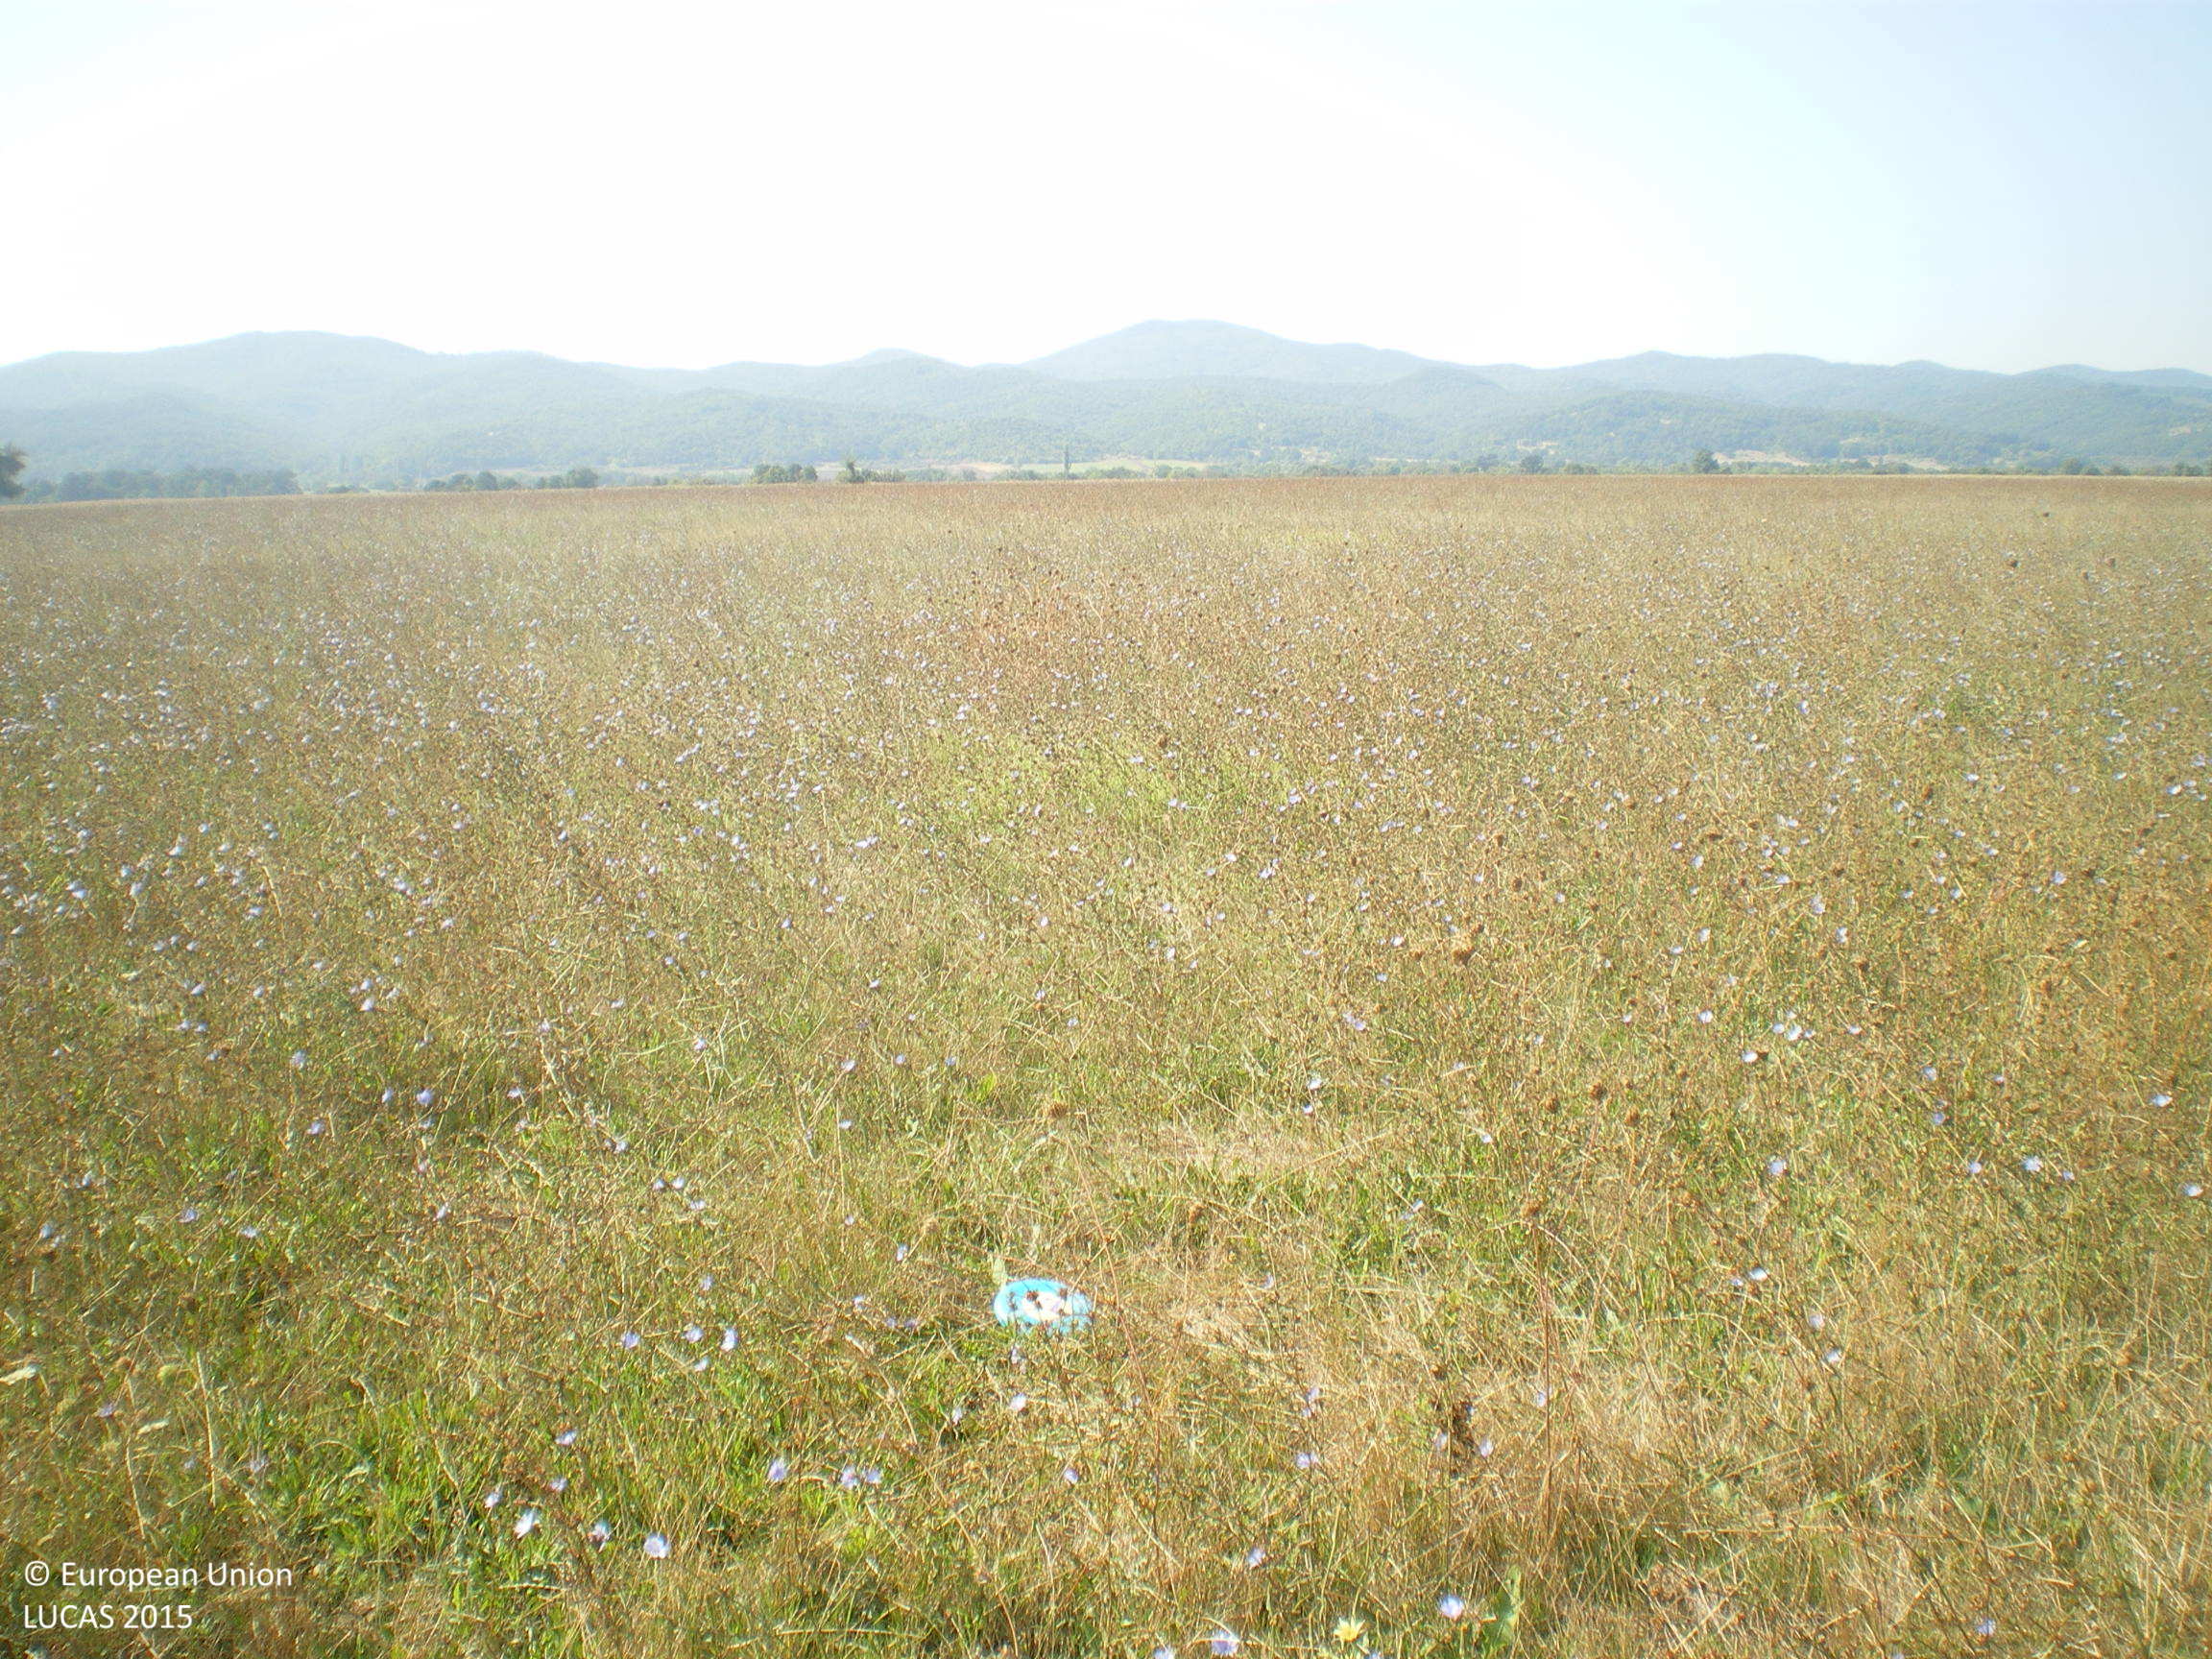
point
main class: Grassland
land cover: Grassland without tree/shrub cover
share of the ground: > 75 %
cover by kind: herbaceous plants 100 %
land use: Agriculture (excluding fallow land and kitchen gardens)
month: September
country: BG
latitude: 41.7786
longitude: 25.9885
